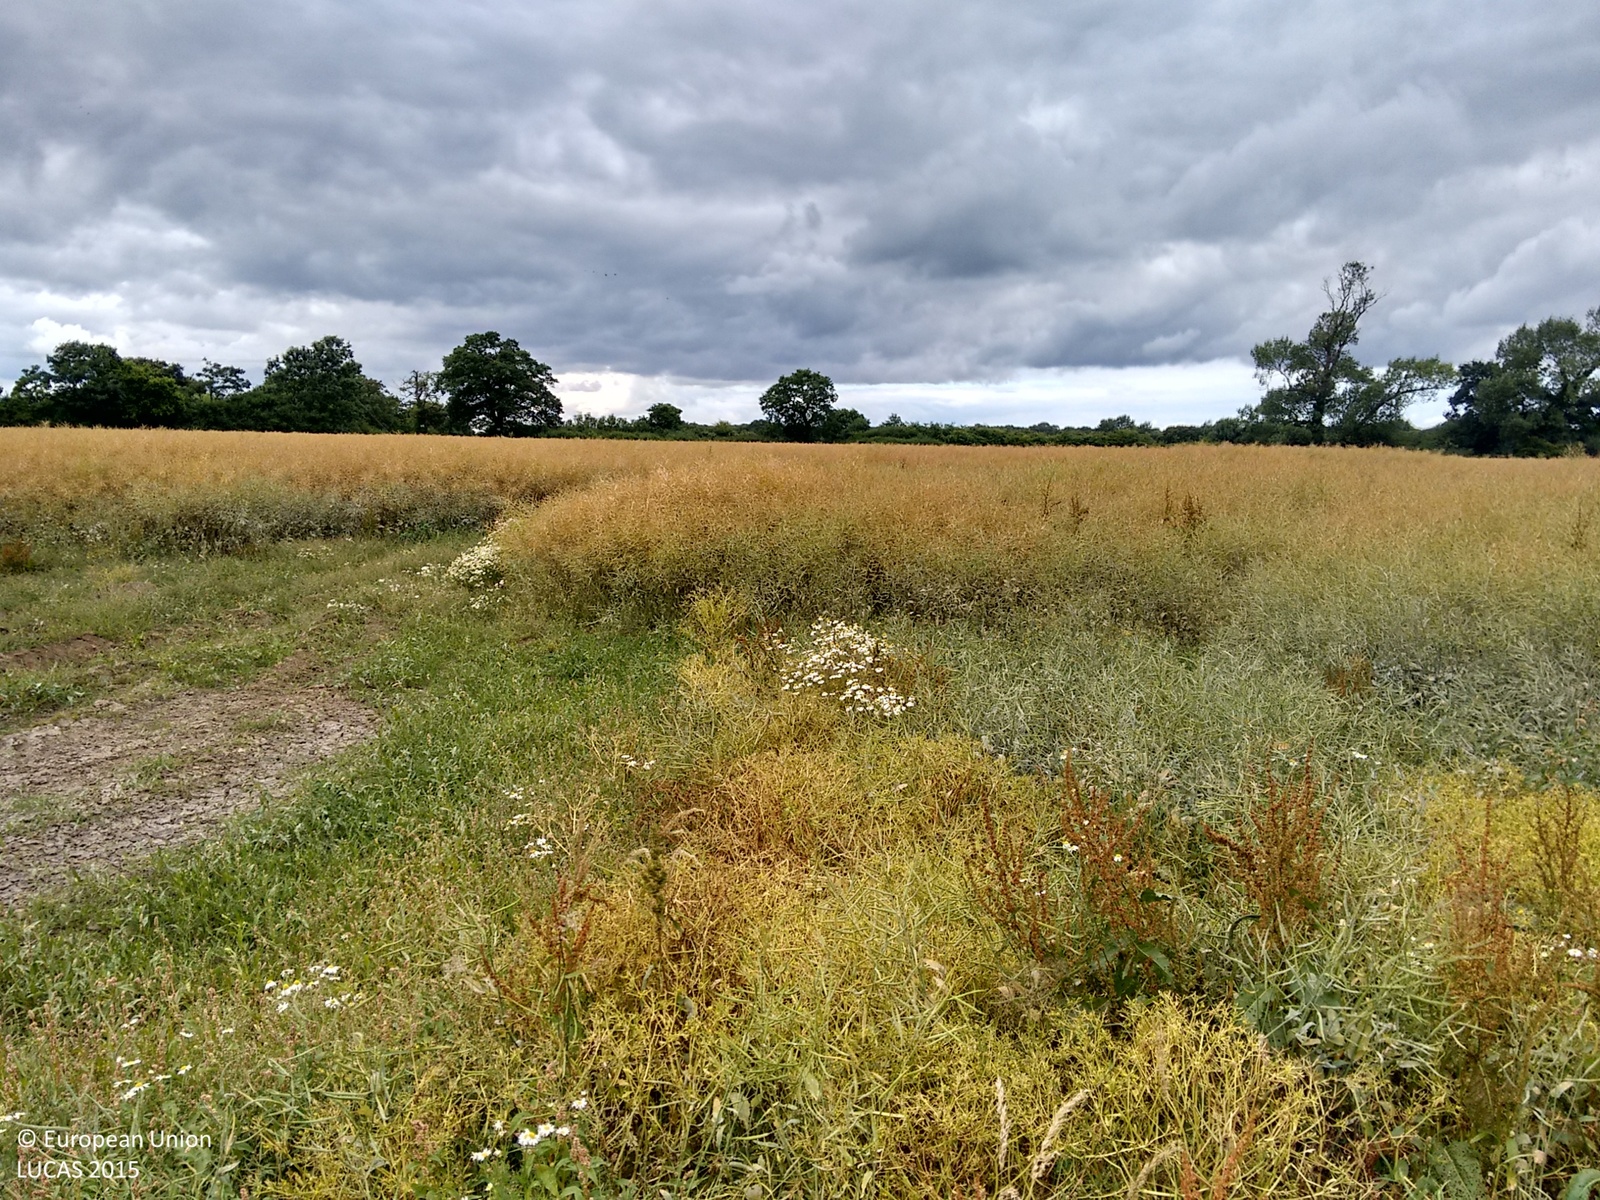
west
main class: Grassland
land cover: Spontaneously vegetated surfaces
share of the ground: > 75 %
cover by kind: herbaceous plants 100 %
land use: Agriculture (excluding fallow land and kitchen gardens)
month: July
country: GB
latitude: 53.2560
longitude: -2.8884
